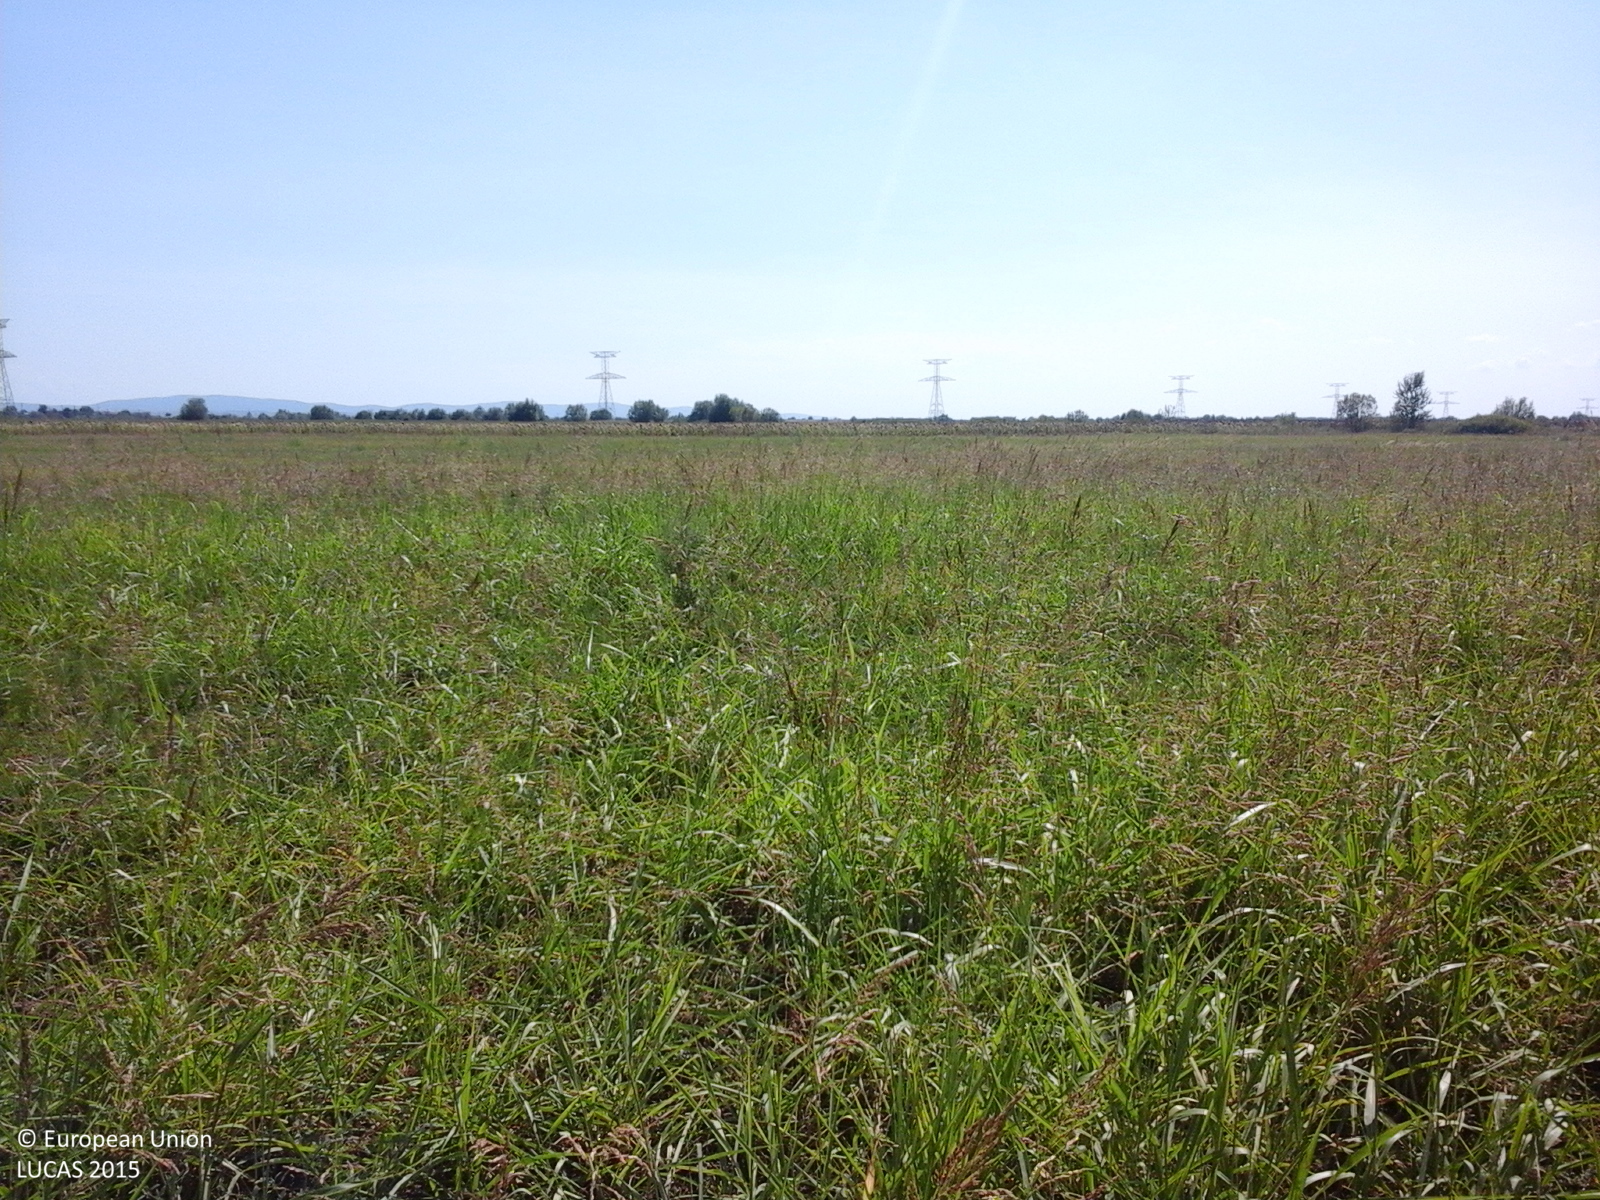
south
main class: Grassland
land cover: Spontaneously vegetated surfaces
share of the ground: > 75 %
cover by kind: herbaceous plants 100 %
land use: Fallow land
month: August
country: RO
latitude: 45.0711
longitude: 21.5249
